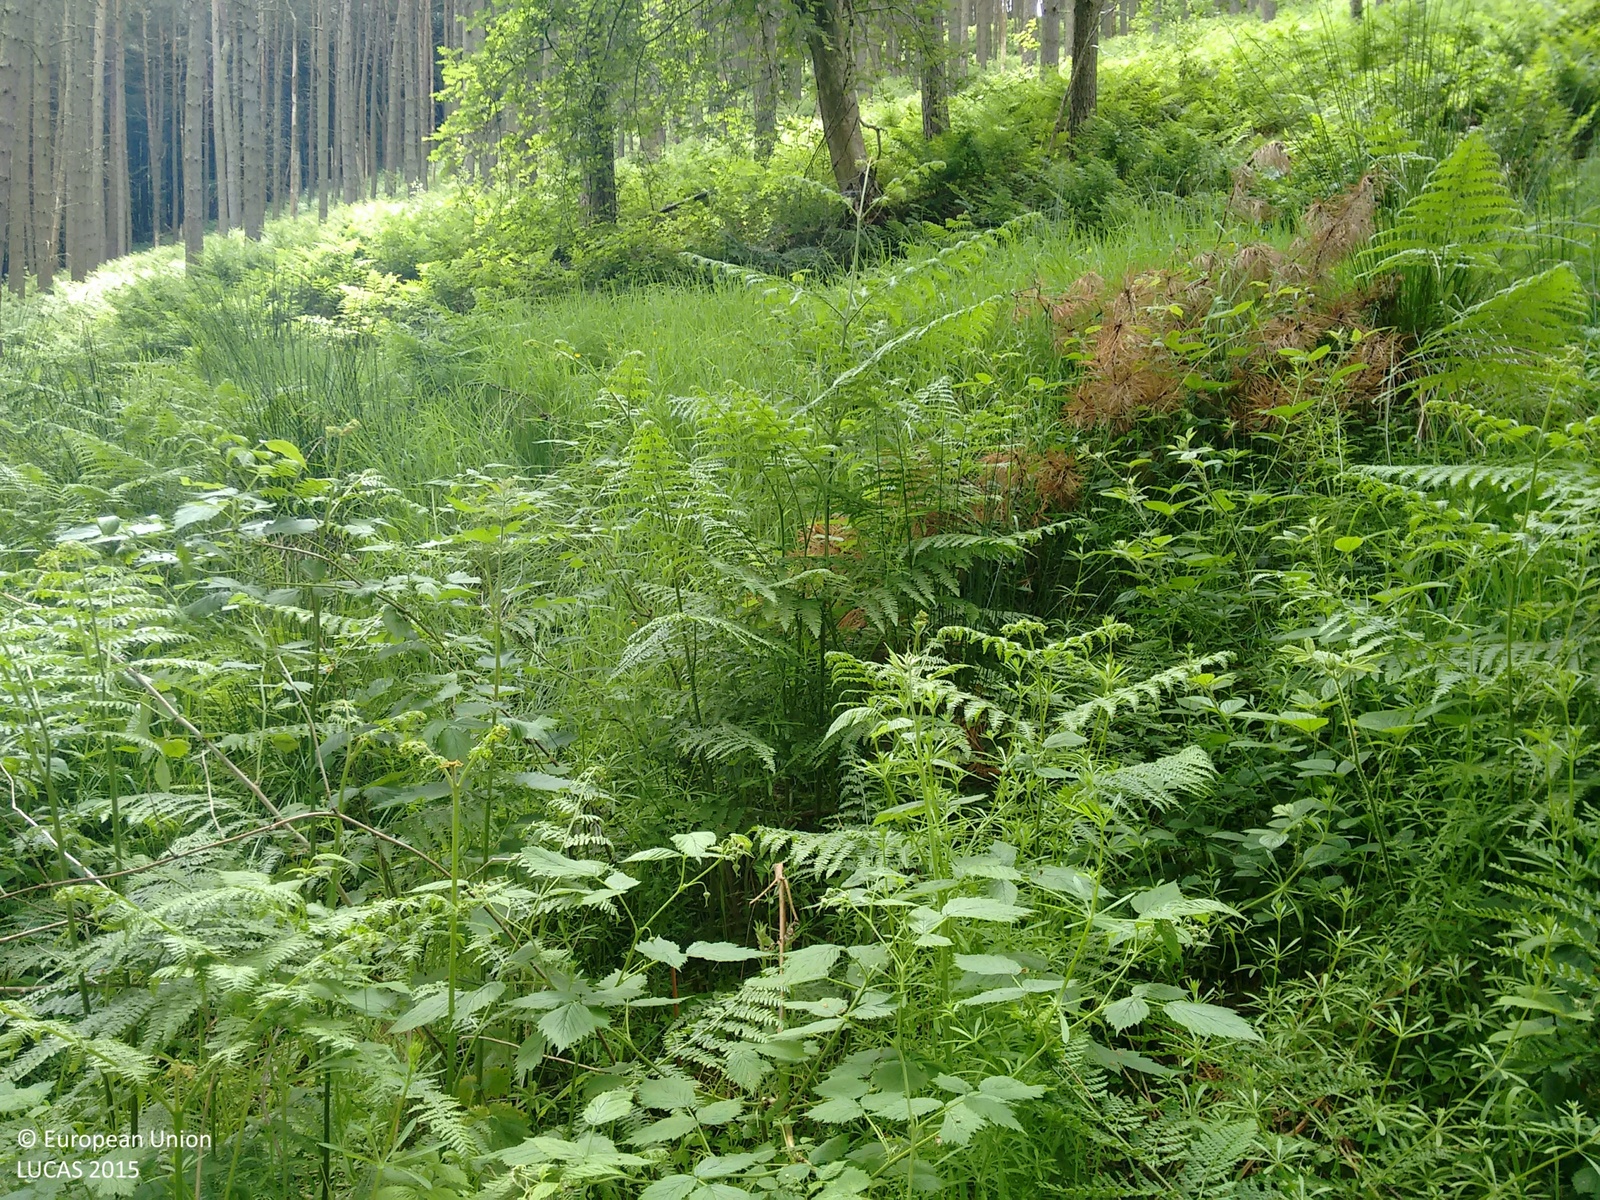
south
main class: Woodland
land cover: Spruce dominated coniferous woodland
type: exotic forest
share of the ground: > 75 %
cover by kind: coniferous forest trees 100 %
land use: Forestry
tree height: > 5 m
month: June
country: GB
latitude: 53.3922
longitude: -1.7376
